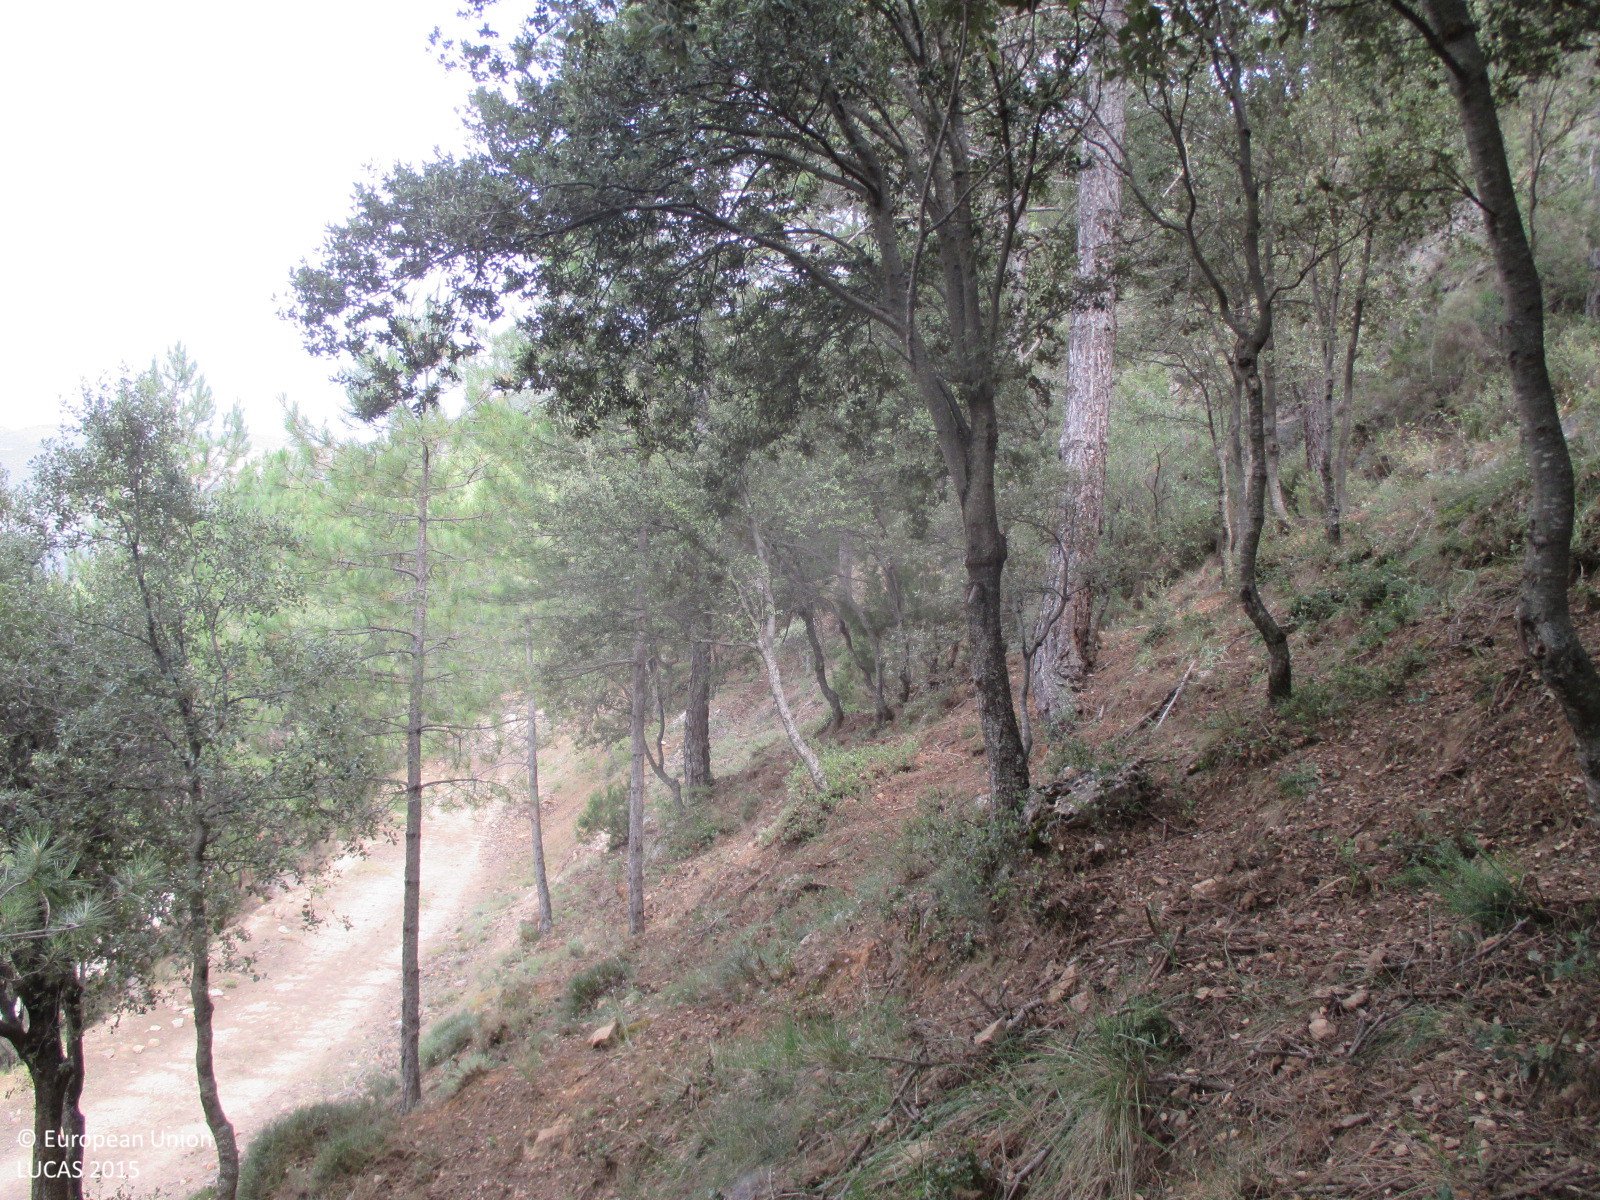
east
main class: Woodland
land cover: Broadleaved woodland
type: broadleaved evergreen forest
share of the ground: > 75 %
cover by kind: broadleaved forest trees 95 %, coniferous forest trees 5 %
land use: Forestry
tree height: > 5 m
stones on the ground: < 10 %
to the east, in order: Broadleaved woodland; Pine dominated coniferous woodland
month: July
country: ES
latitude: 38.1870
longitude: -2.4735
